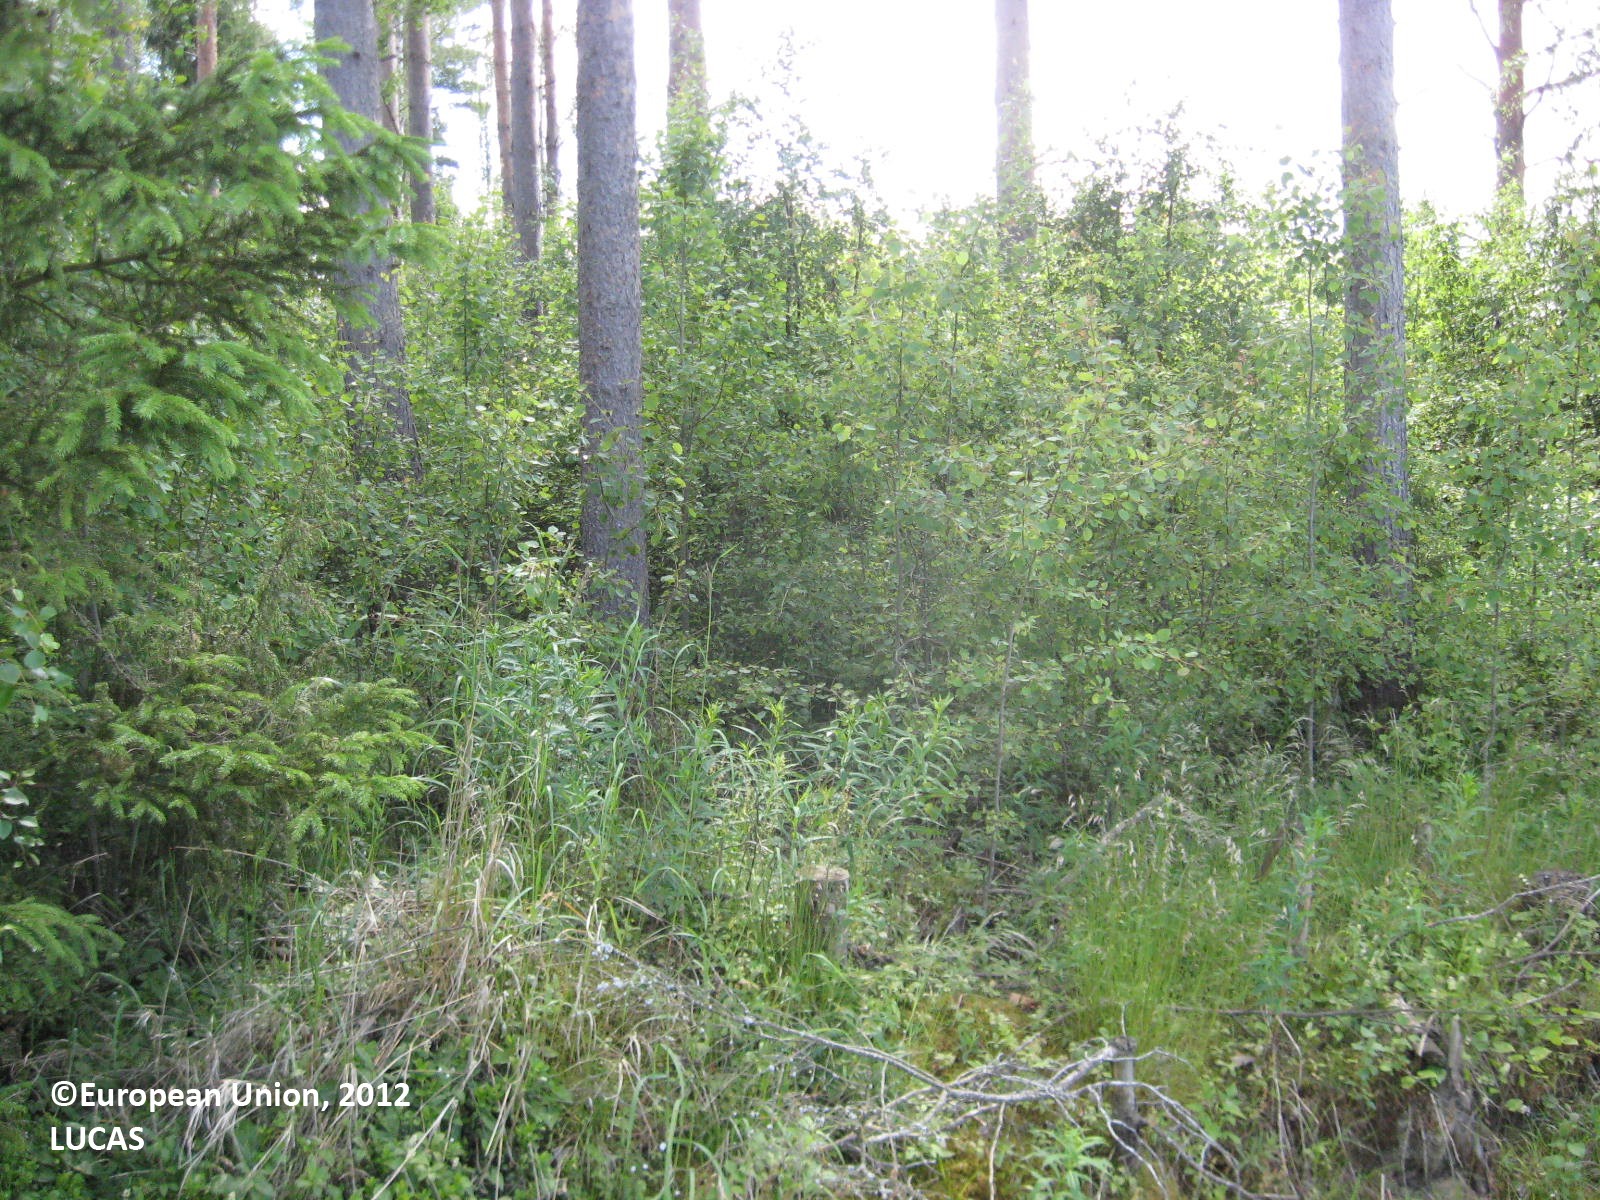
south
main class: Cropland
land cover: Barley
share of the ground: > 75 %
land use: Agriculture (excluding fallow land and kitchen gardens)
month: June
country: FI
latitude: 62.7959
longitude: 22.5833
